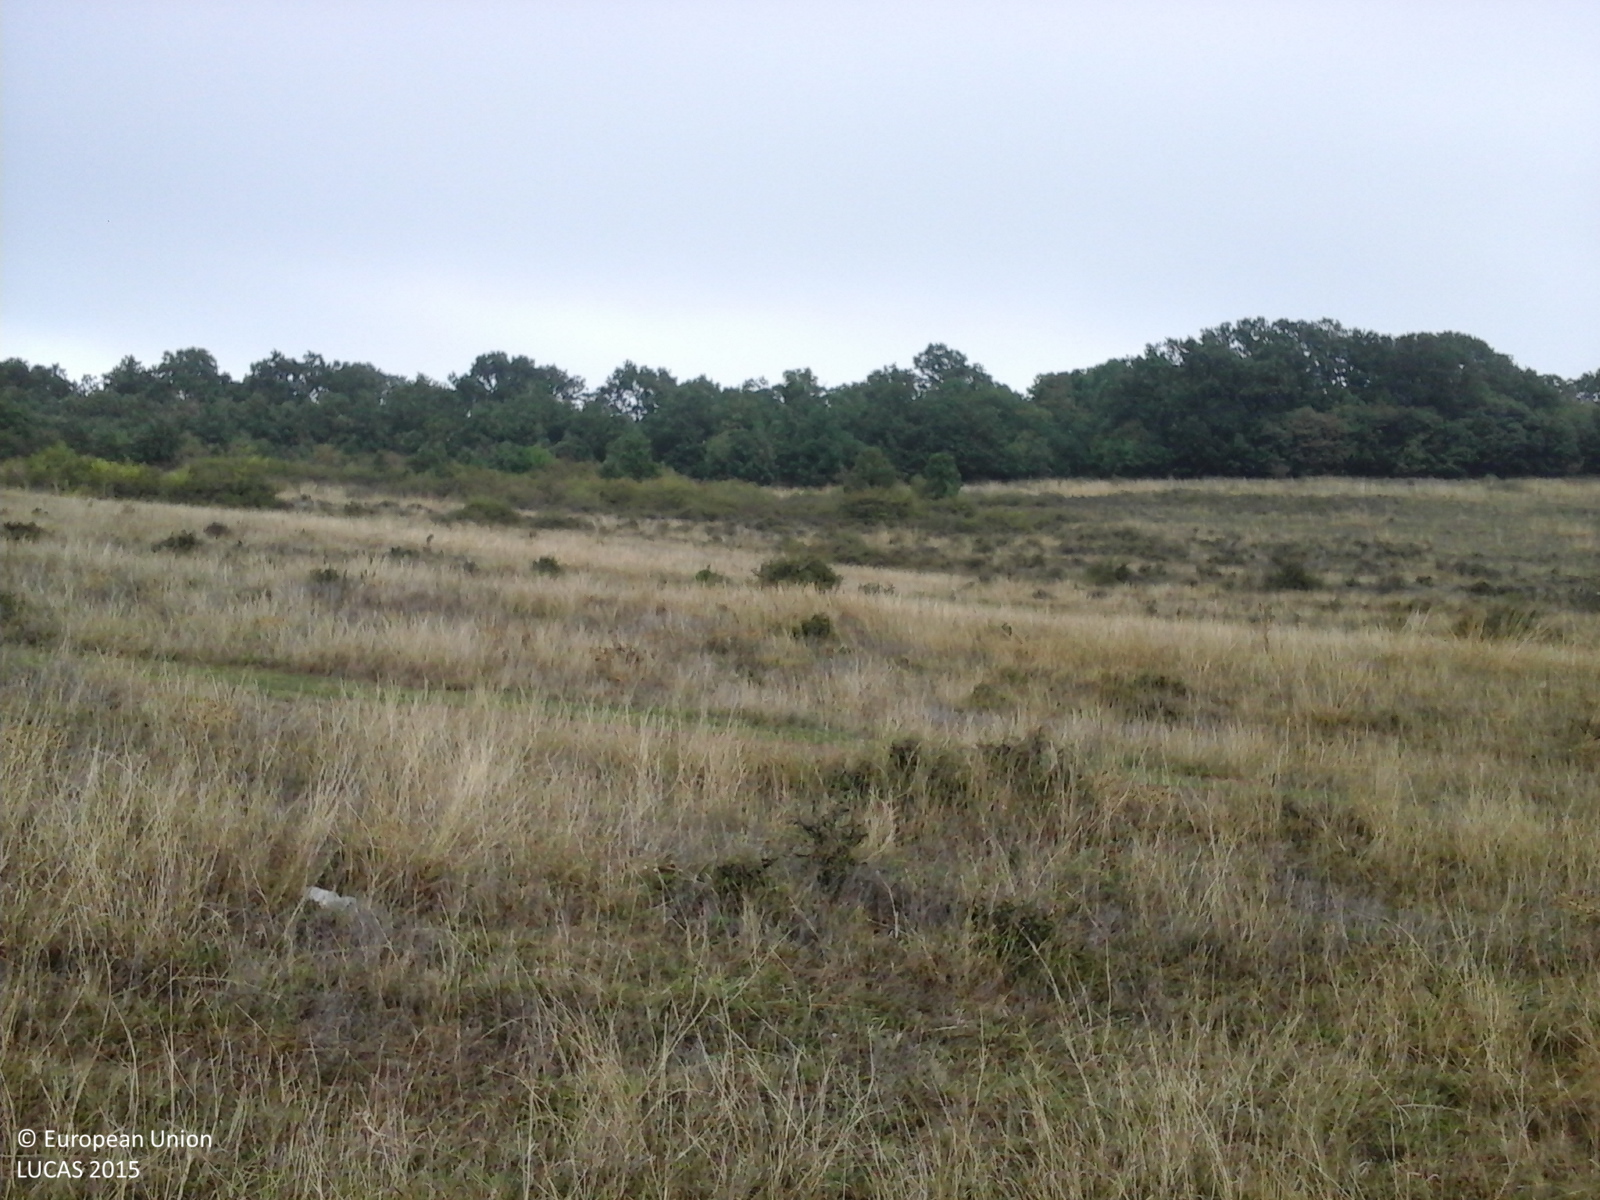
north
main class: Grassland
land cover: Grassland with sparse tree/shrub cover
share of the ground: > 75 %
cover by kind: herbaceous plants 85 %, shrubs 10 %, broadleaved forest trees 5 %
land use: Agriculture (excluding fallow land and kitchen gardens)
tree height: < 5 m
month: September
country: RO
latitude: 45.8971
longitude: 22.8777
